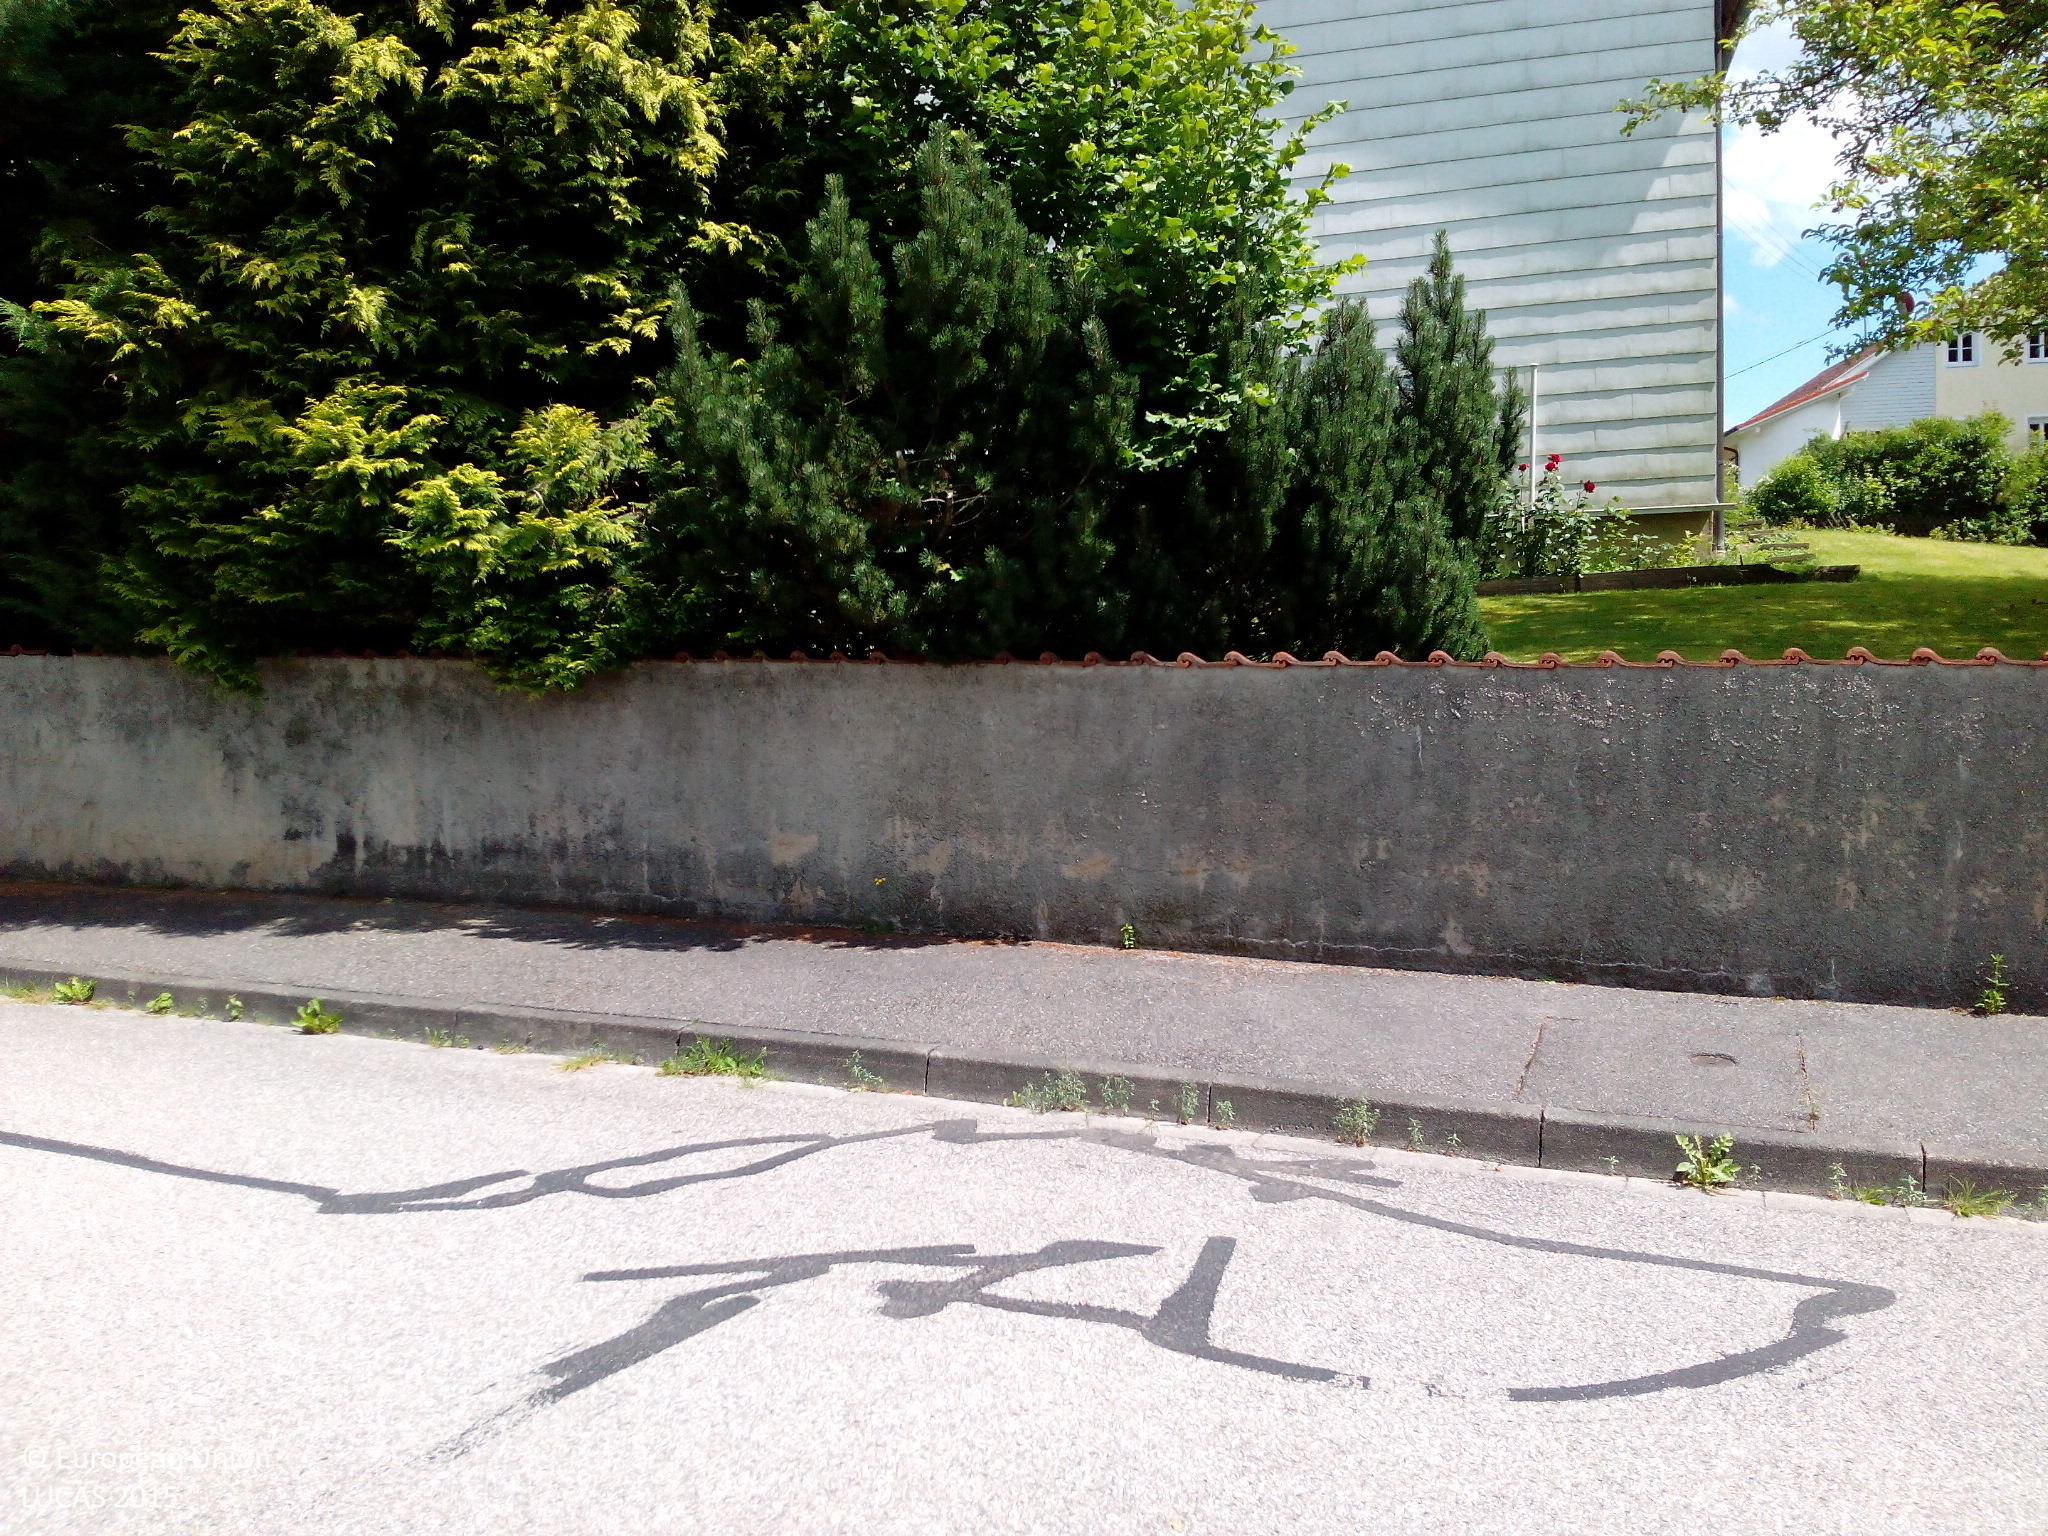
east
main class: Grassland
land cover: Grassland without tree/shrub cover
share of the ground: > 75 %
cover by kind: herbaceous plants 100 %
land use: Residential
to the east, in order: Grassland without tree/shrub cover; Managed hedges; Artificial constructions in urban areas
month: June
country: DE
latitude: 48.3058
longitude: 12.3854
